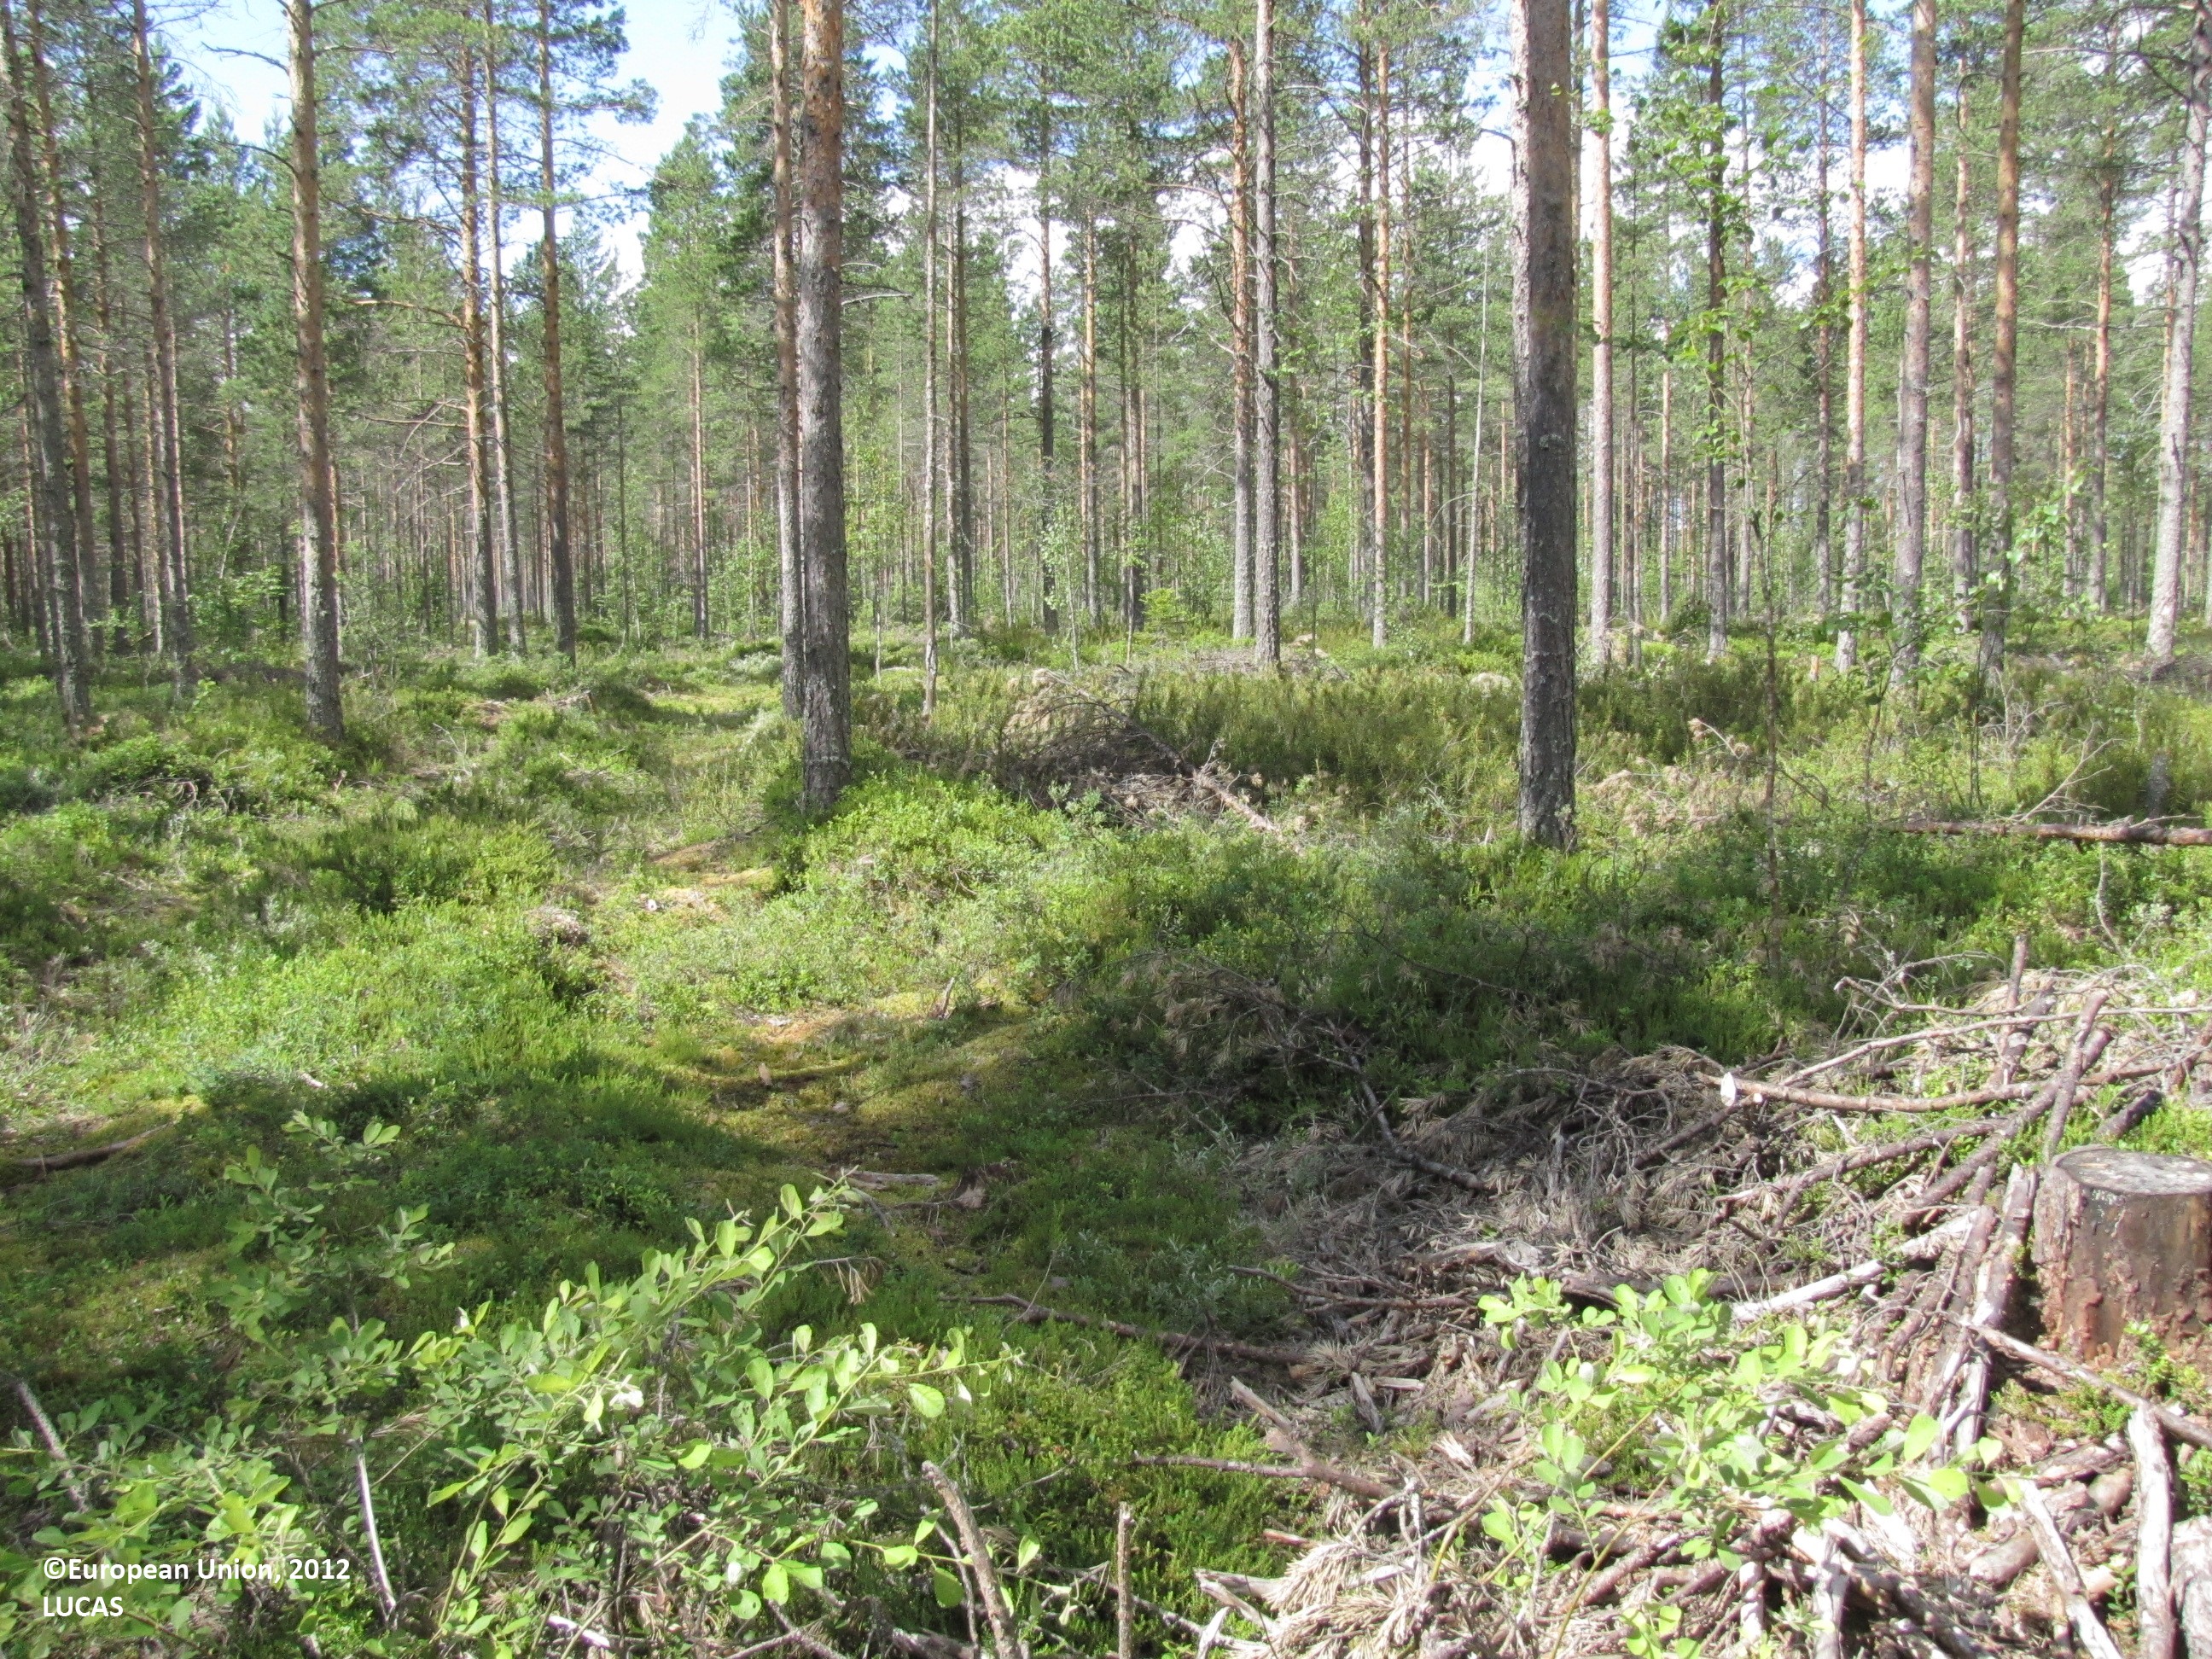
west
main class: Woodland
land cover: Pine dominated coniferous woodland
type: boreal forest
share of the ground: 50 - 75 %
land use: Forestry
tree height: > 5 m
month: July
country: FI
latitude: 62.6692
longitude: 23.2039
